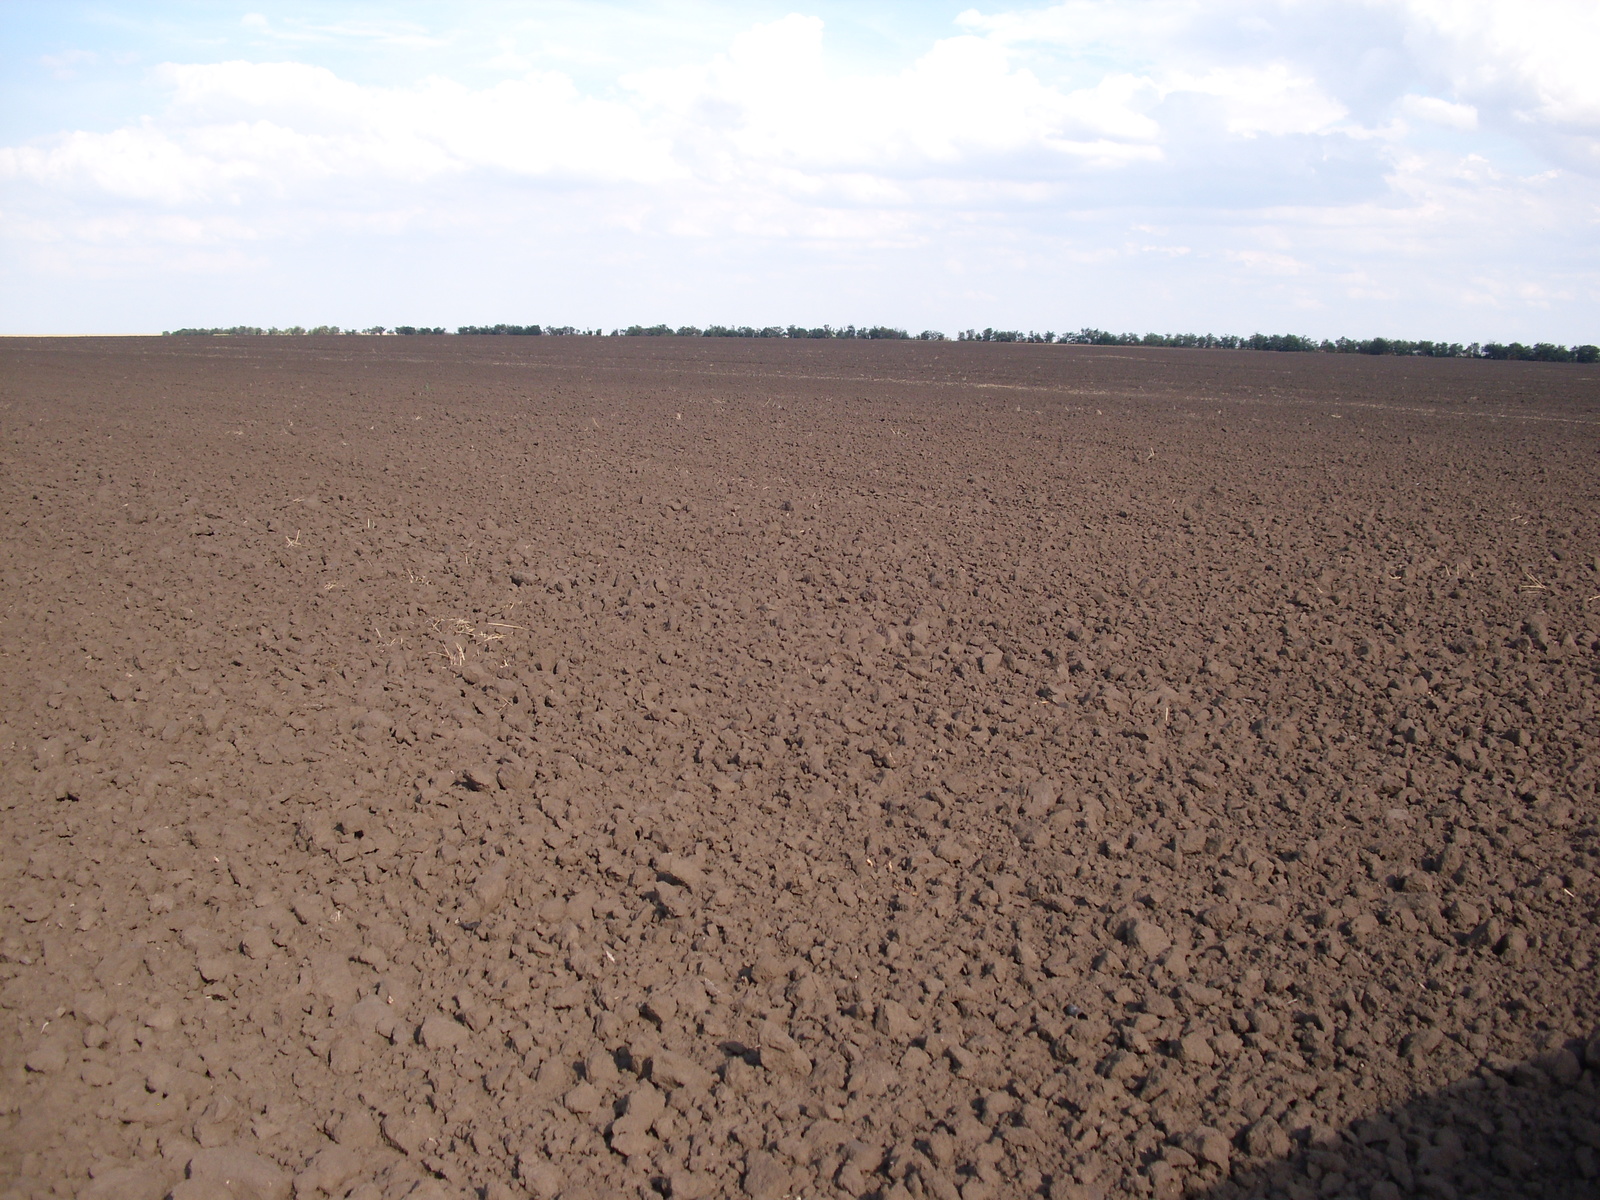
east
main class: Cropland
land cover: Common wheat
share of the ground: < 10 %
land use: Agriculture (excluding fallow land and kitchen gardens)
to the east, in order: Common wheat
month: August
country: BG
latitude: 43.7466
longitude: 23.2938
